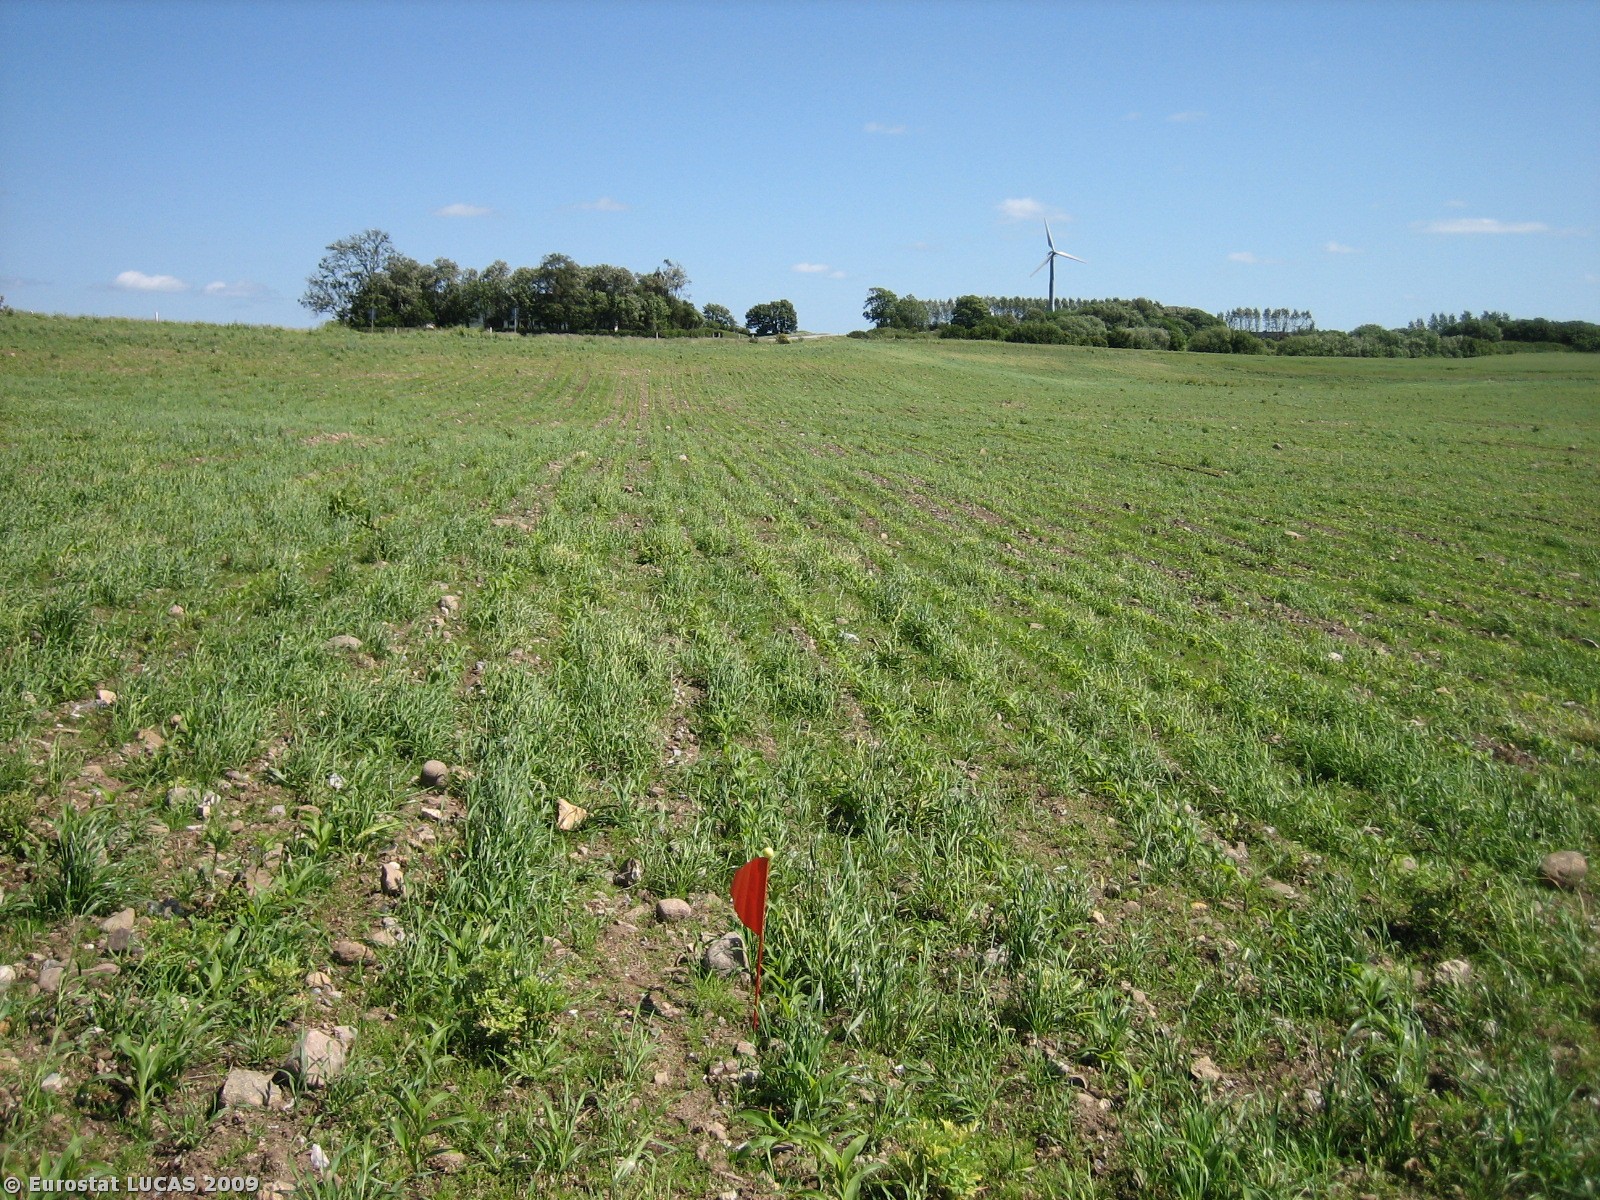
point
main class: Cropland
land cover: Maize
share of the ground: < 10 %
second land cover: Spontaneously vegetated surfaces
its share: 25 - 50 %
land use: Agriculture (excluding fallow land and kitchen gardens)
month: June
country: DK
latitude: 55.9177
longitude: 9.6963
